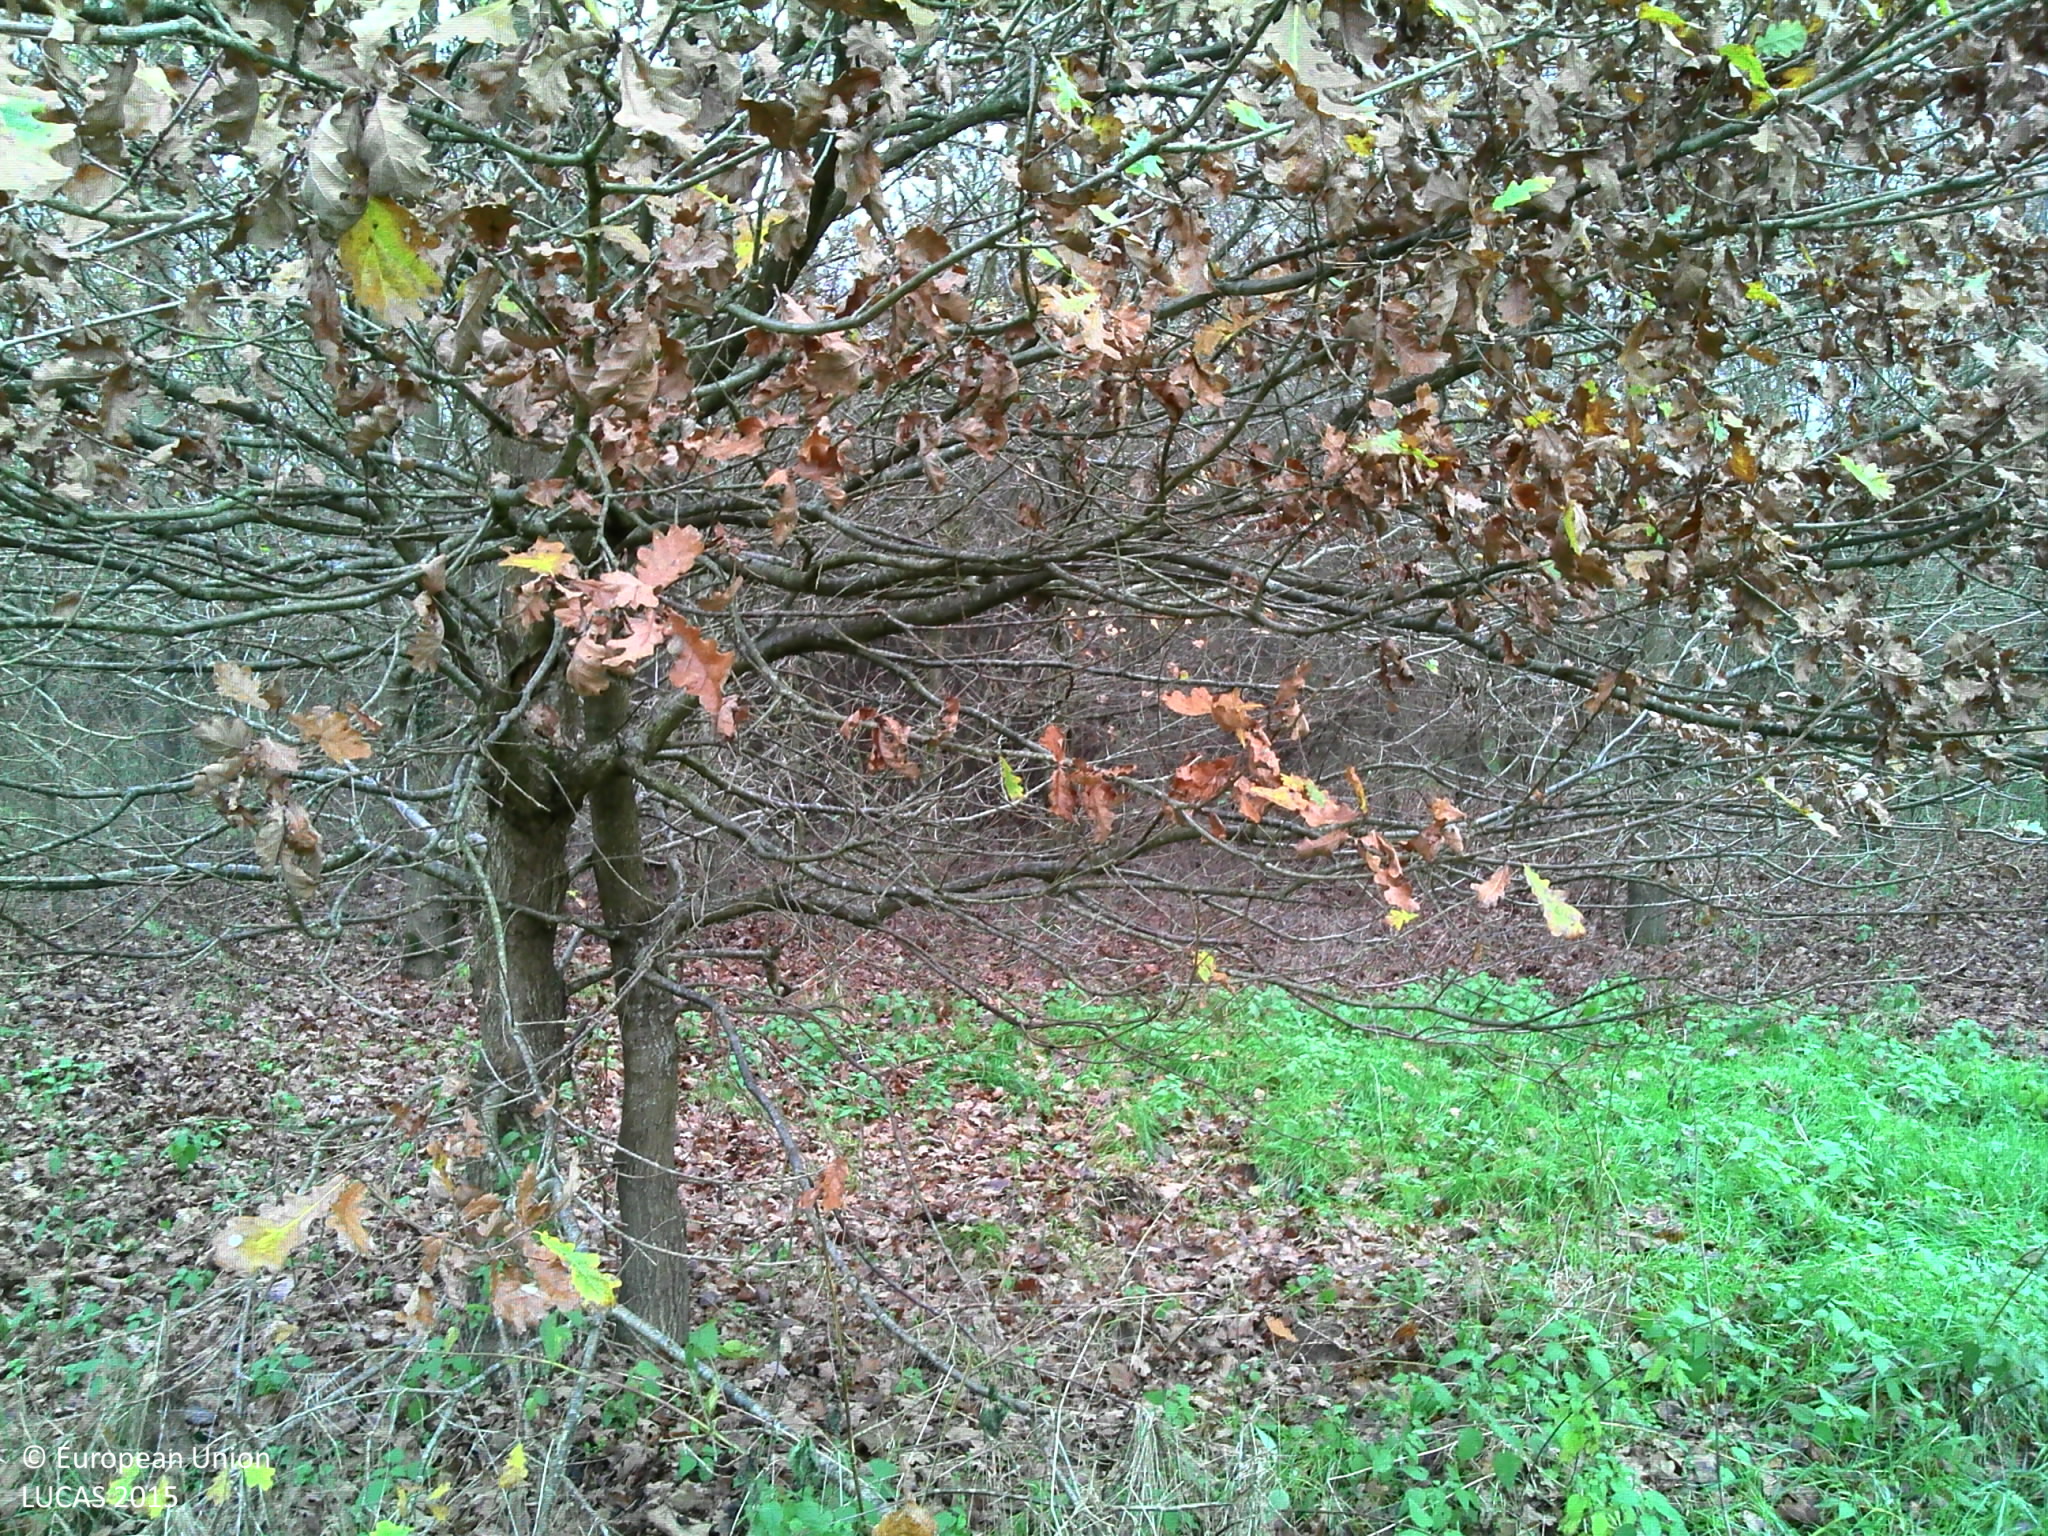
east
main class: Woodland
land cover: Broadleaved woodland
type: acidophilous oak and oak-birch forest
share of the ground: > 75 %
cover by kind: broadleaved forest trees 60 %, herbaceous plants 30 %, shrubs 10 %
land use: Forestry
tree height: > 5 m
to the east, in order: Broadleaved woodland; Tracks; Broadleaved woodland; Inland fresh water bodies; Shrubland with sparse tree cover; Tracks; Broadleaved woodland; Fences; Grassland without tree/shrub cover
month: November
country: FR
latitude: 46.6825
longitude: 3.2907
